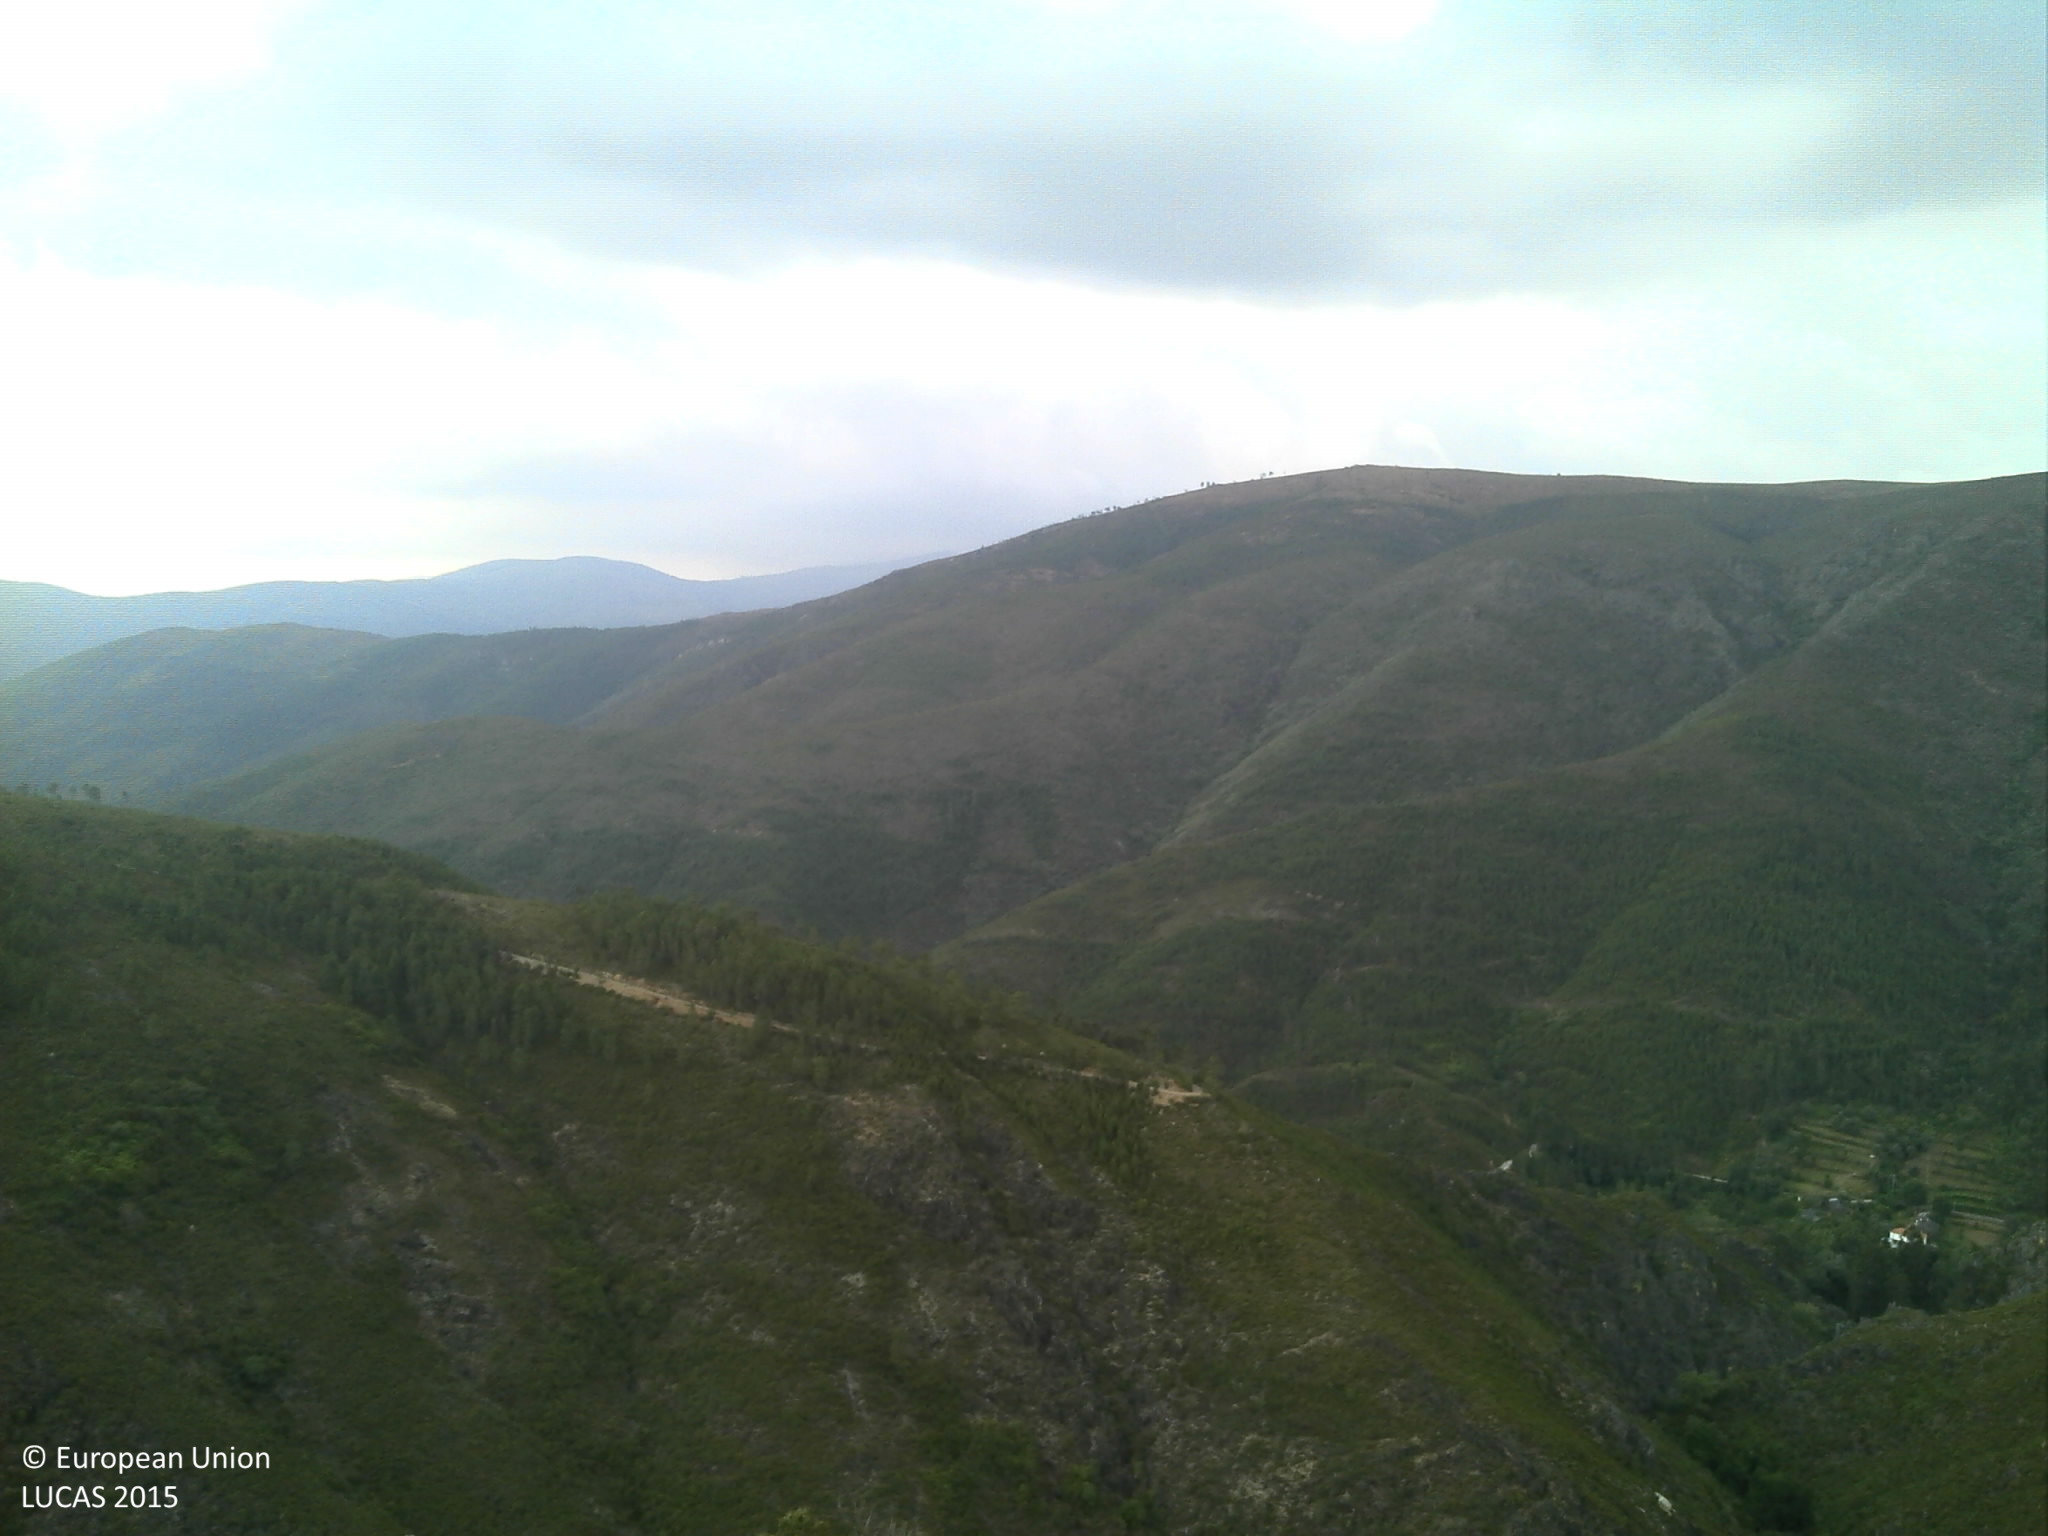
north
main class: Shrubland
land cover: Shrubland without tree cover
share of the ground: > 75 %
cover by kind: shrubs 80 %, consolidated bare surface 15 %, unconsolidated bare surface 5 %
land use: Semi-natural and natural areas not in use
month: June
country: PT
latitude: 40.8976
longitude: -8.0929
